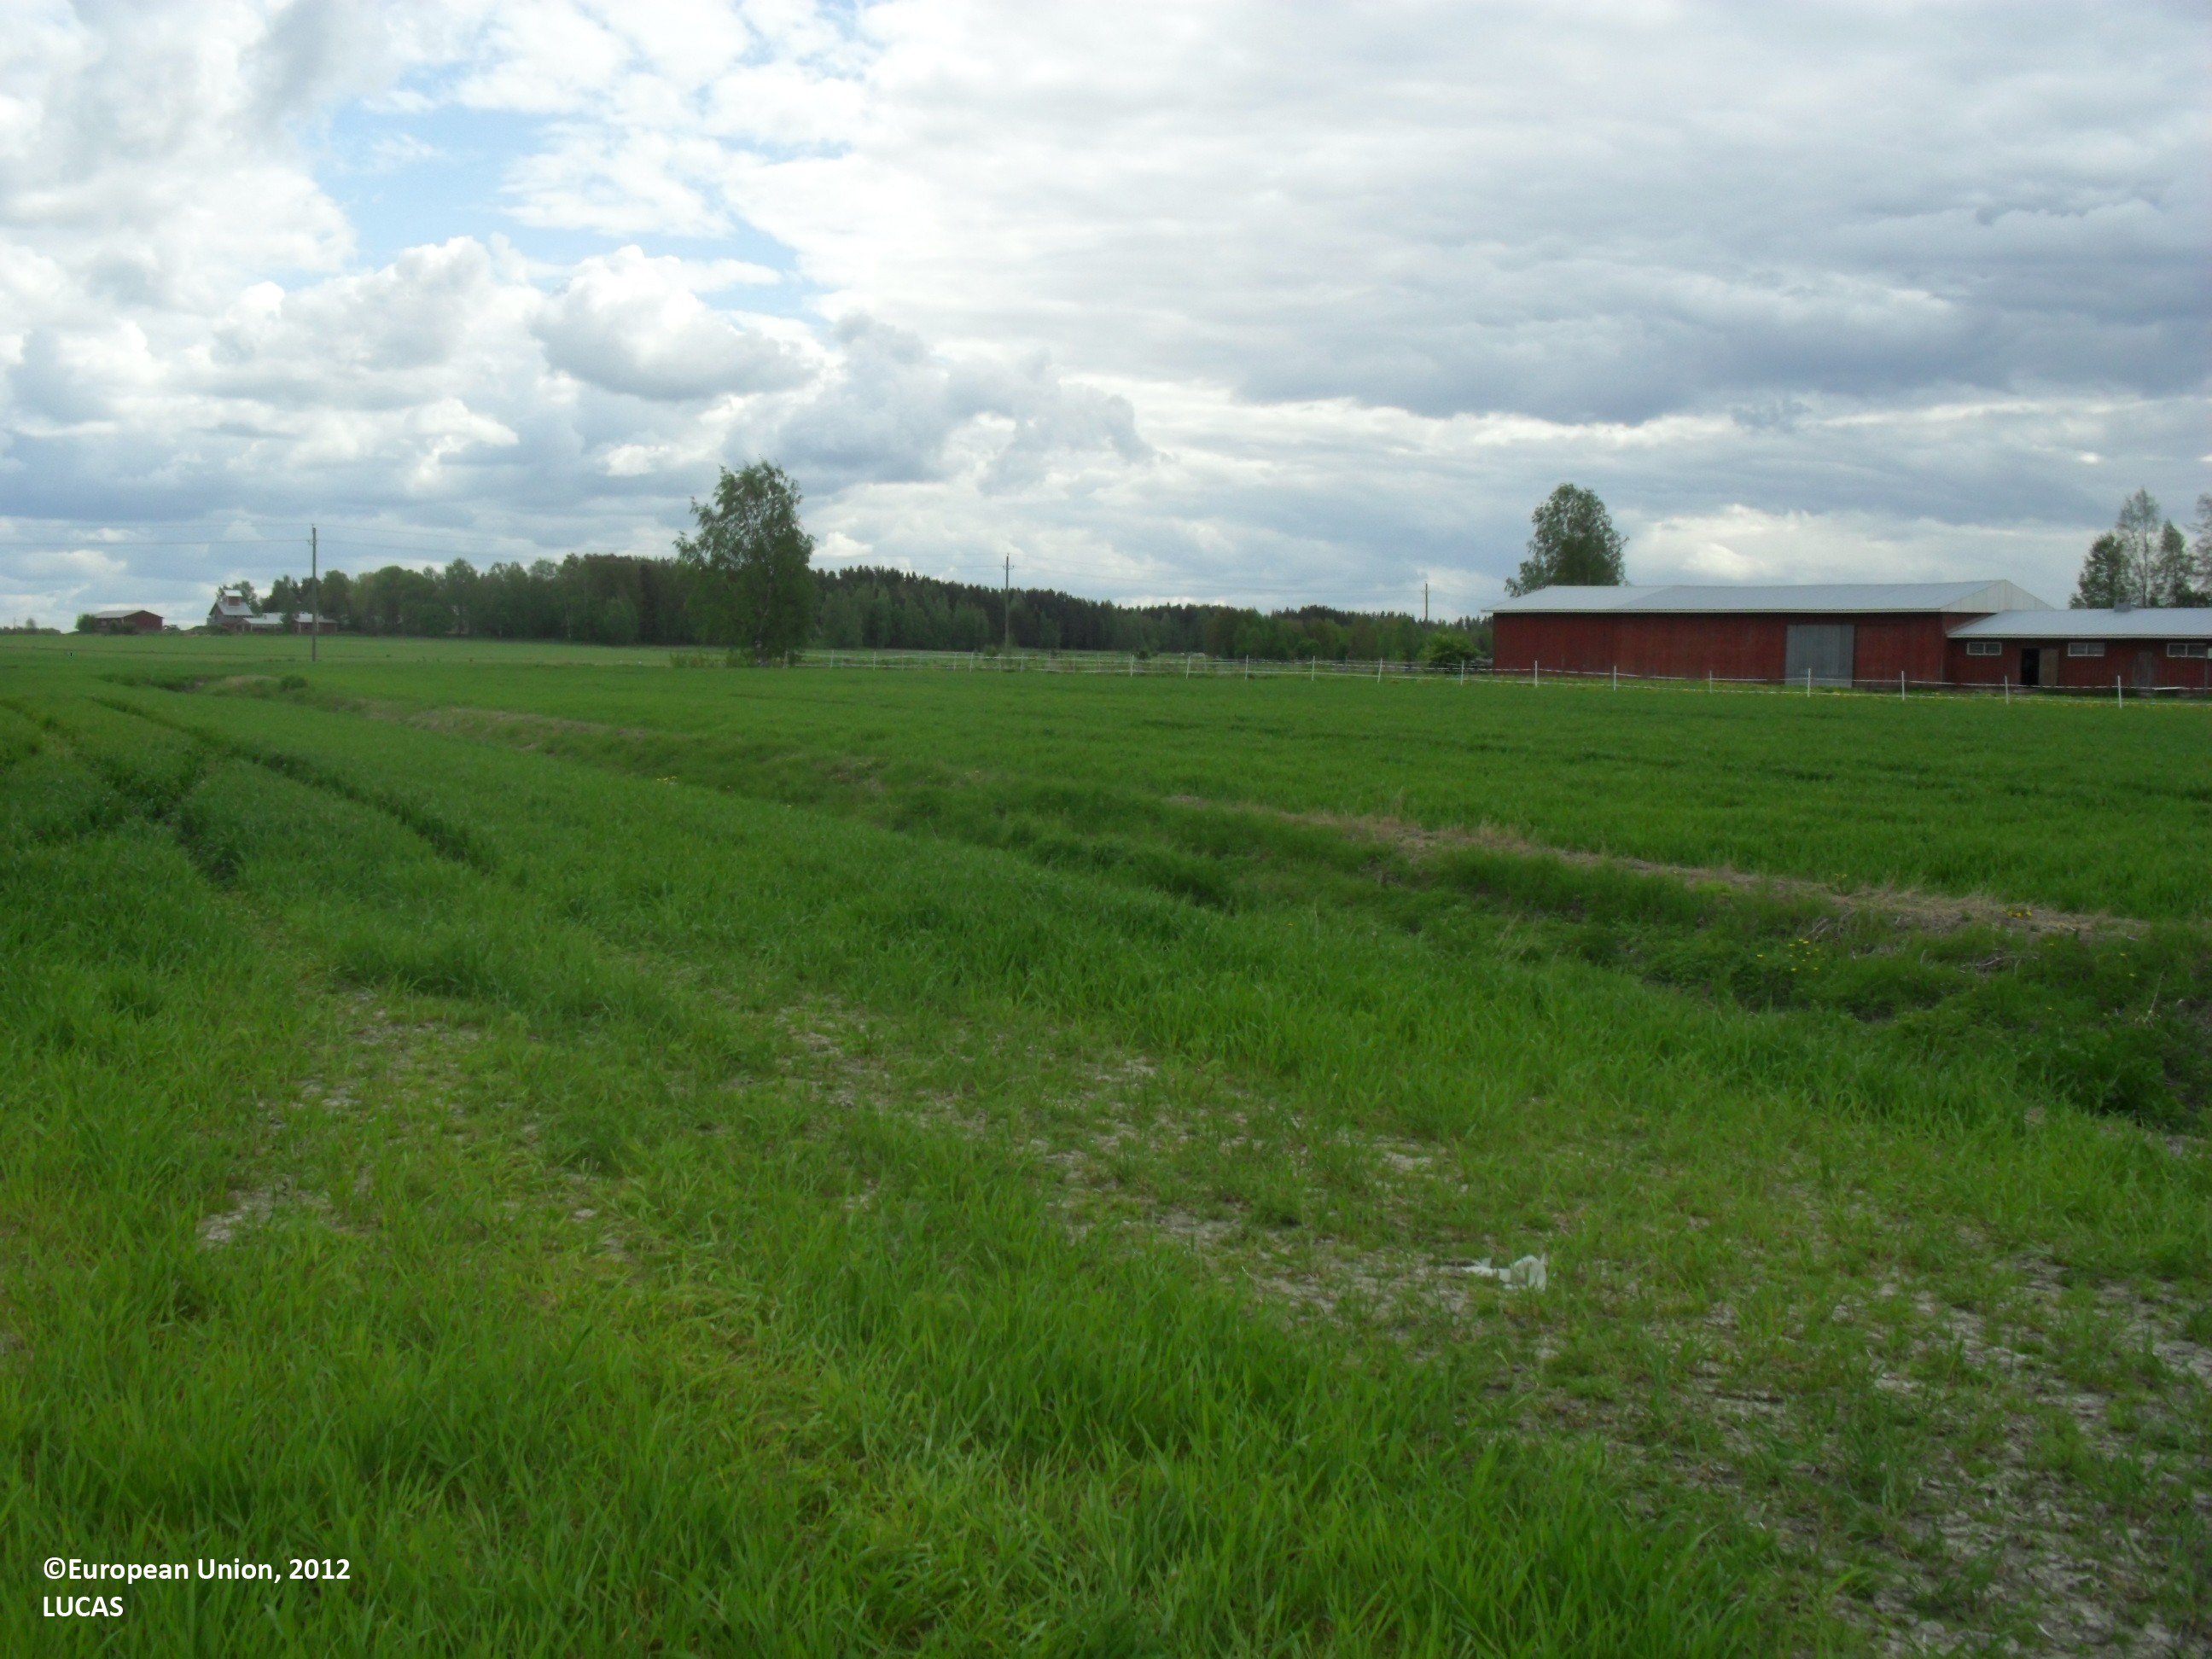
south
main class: Cropland
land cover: Common wheat
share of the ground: 50 - 75 %
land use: Agriculture (excluding fallow land and kitchen gardens)
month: June
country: FI
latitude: 62.8582
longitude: 22.9286
